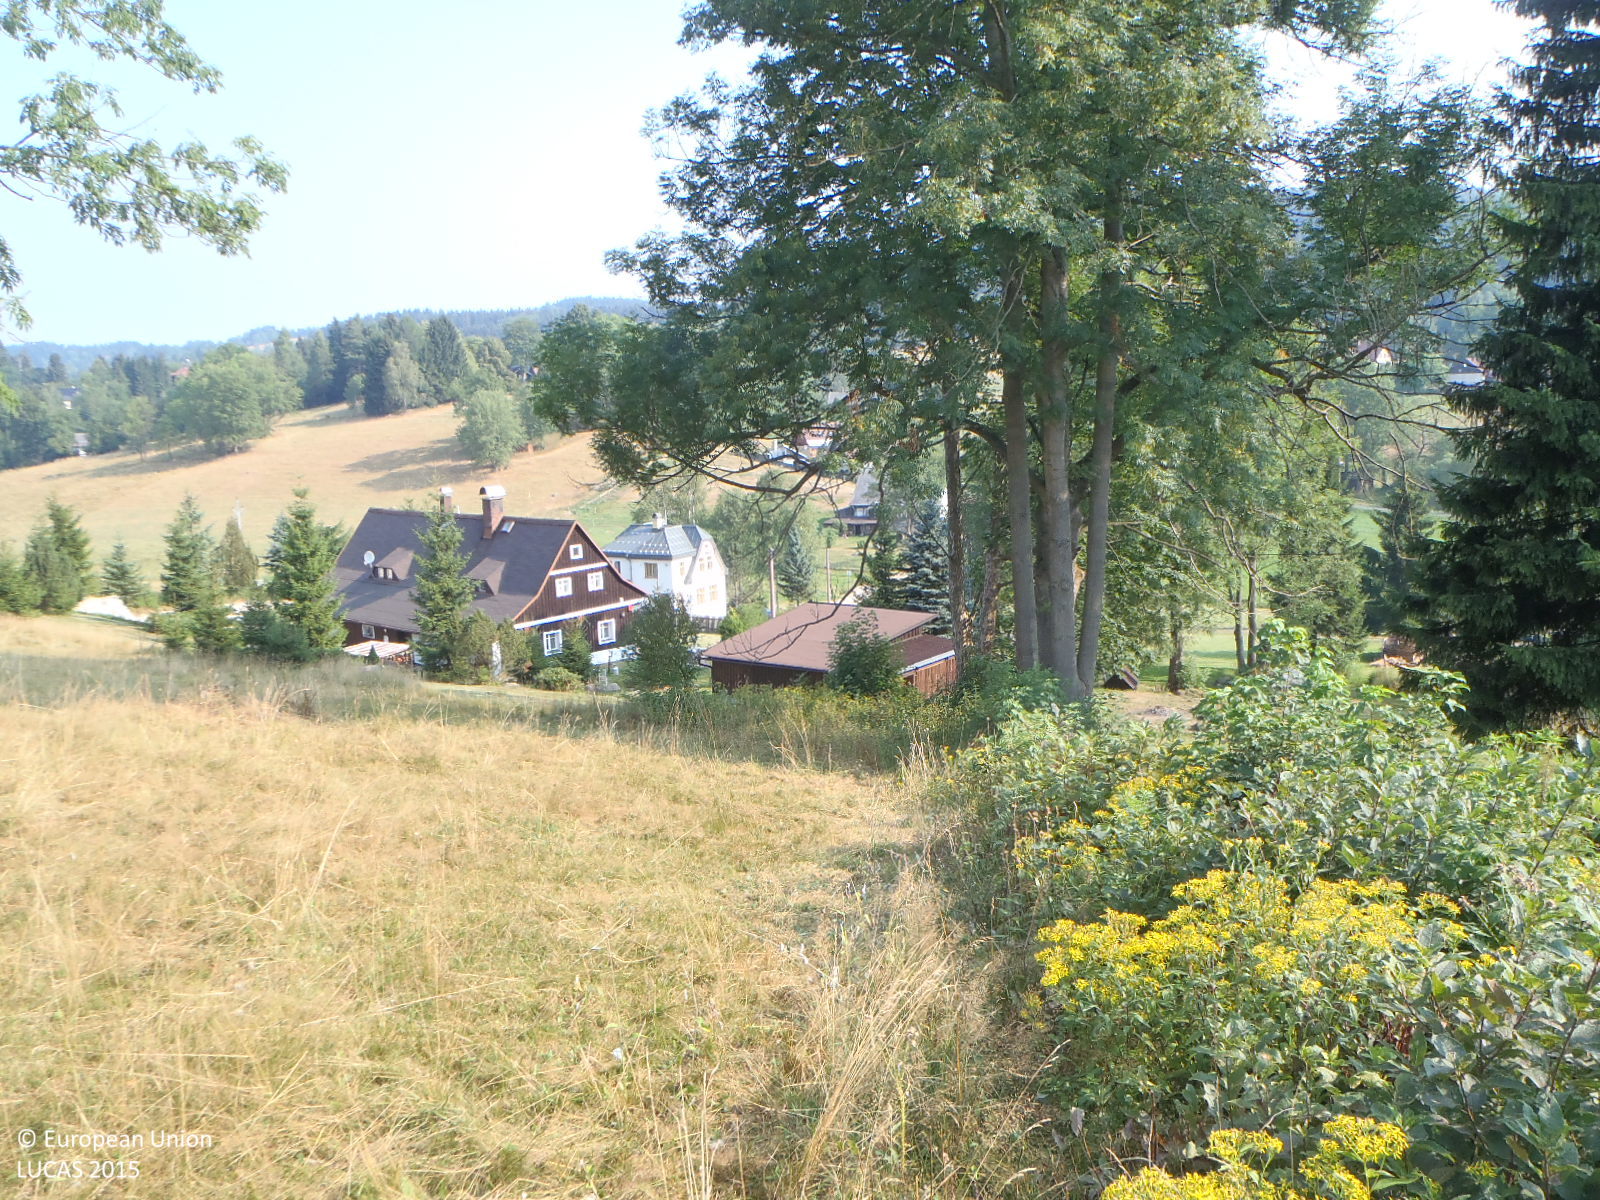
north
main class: Grassland
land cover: Grassland without tree/shrub cover
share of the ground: > 75 %
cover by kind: herbaceous plants 100 %
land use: Agriculture (excluding fallow land and kitchen gardens)
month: August
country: CZ
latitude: 50.7488
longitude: 15.2334
